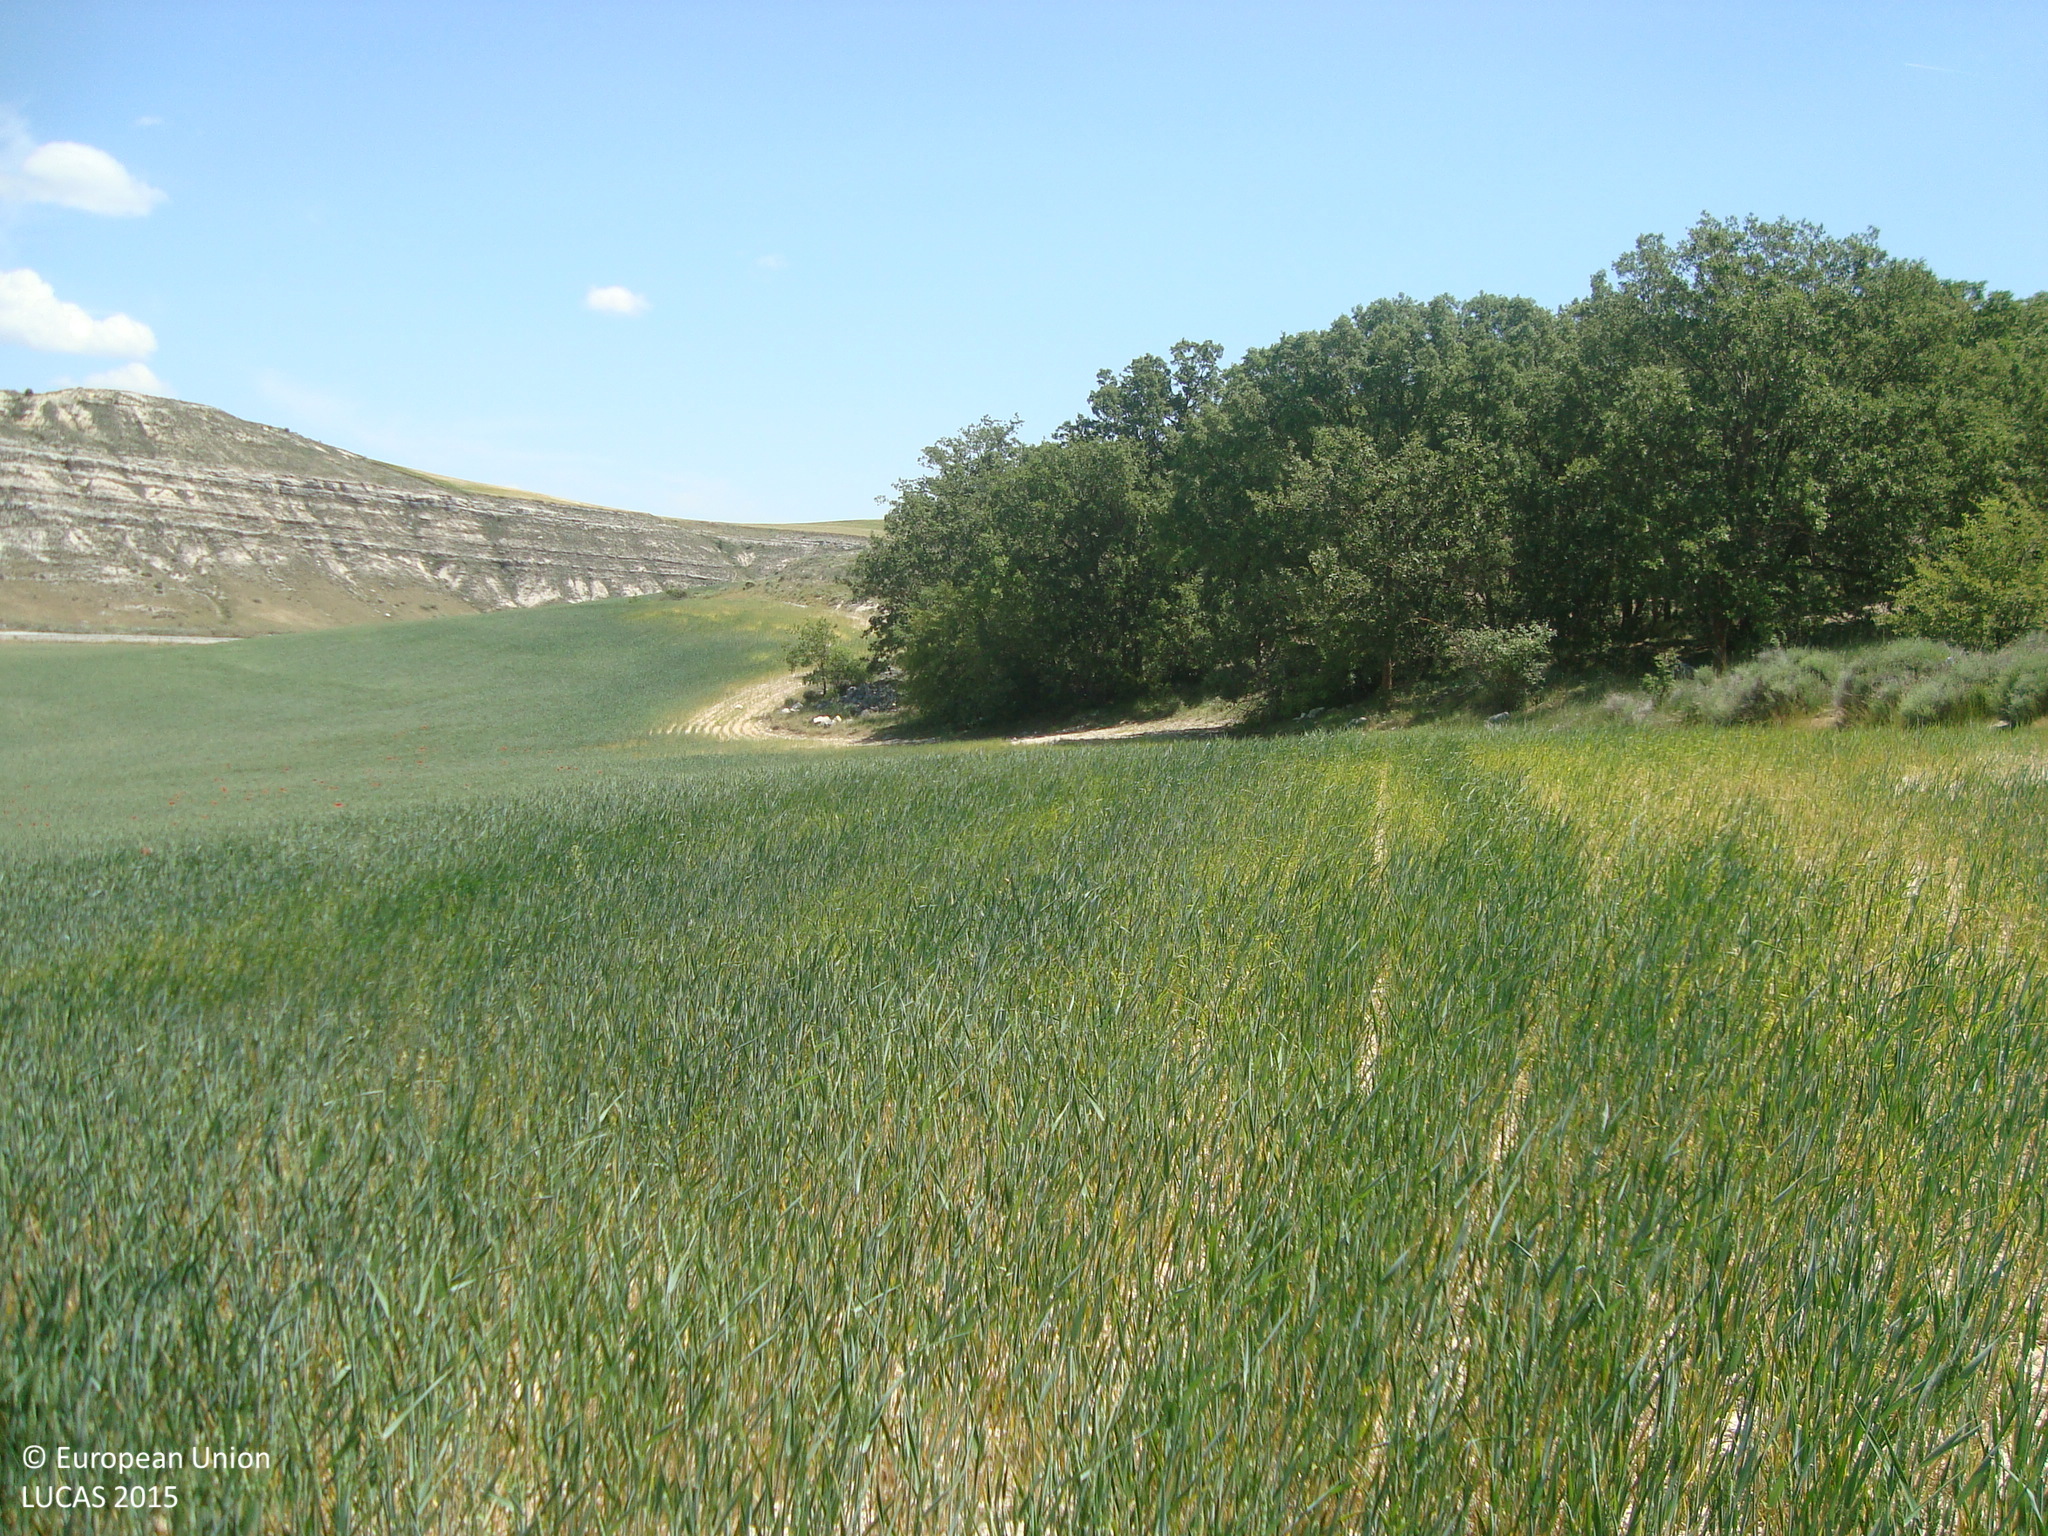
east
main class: Cropland
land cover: Common wheat
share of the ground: 50 - 75 %
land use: Agriculture (excluding fallow land and kitchen gardens)
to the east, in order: Common wheat; Broadleaved woodland; Shrubland with sparse tree cover; Rivers and streams; Grassland without tree/shrub cover
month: May
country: ES
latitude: 41.5459
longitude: -4.1440
